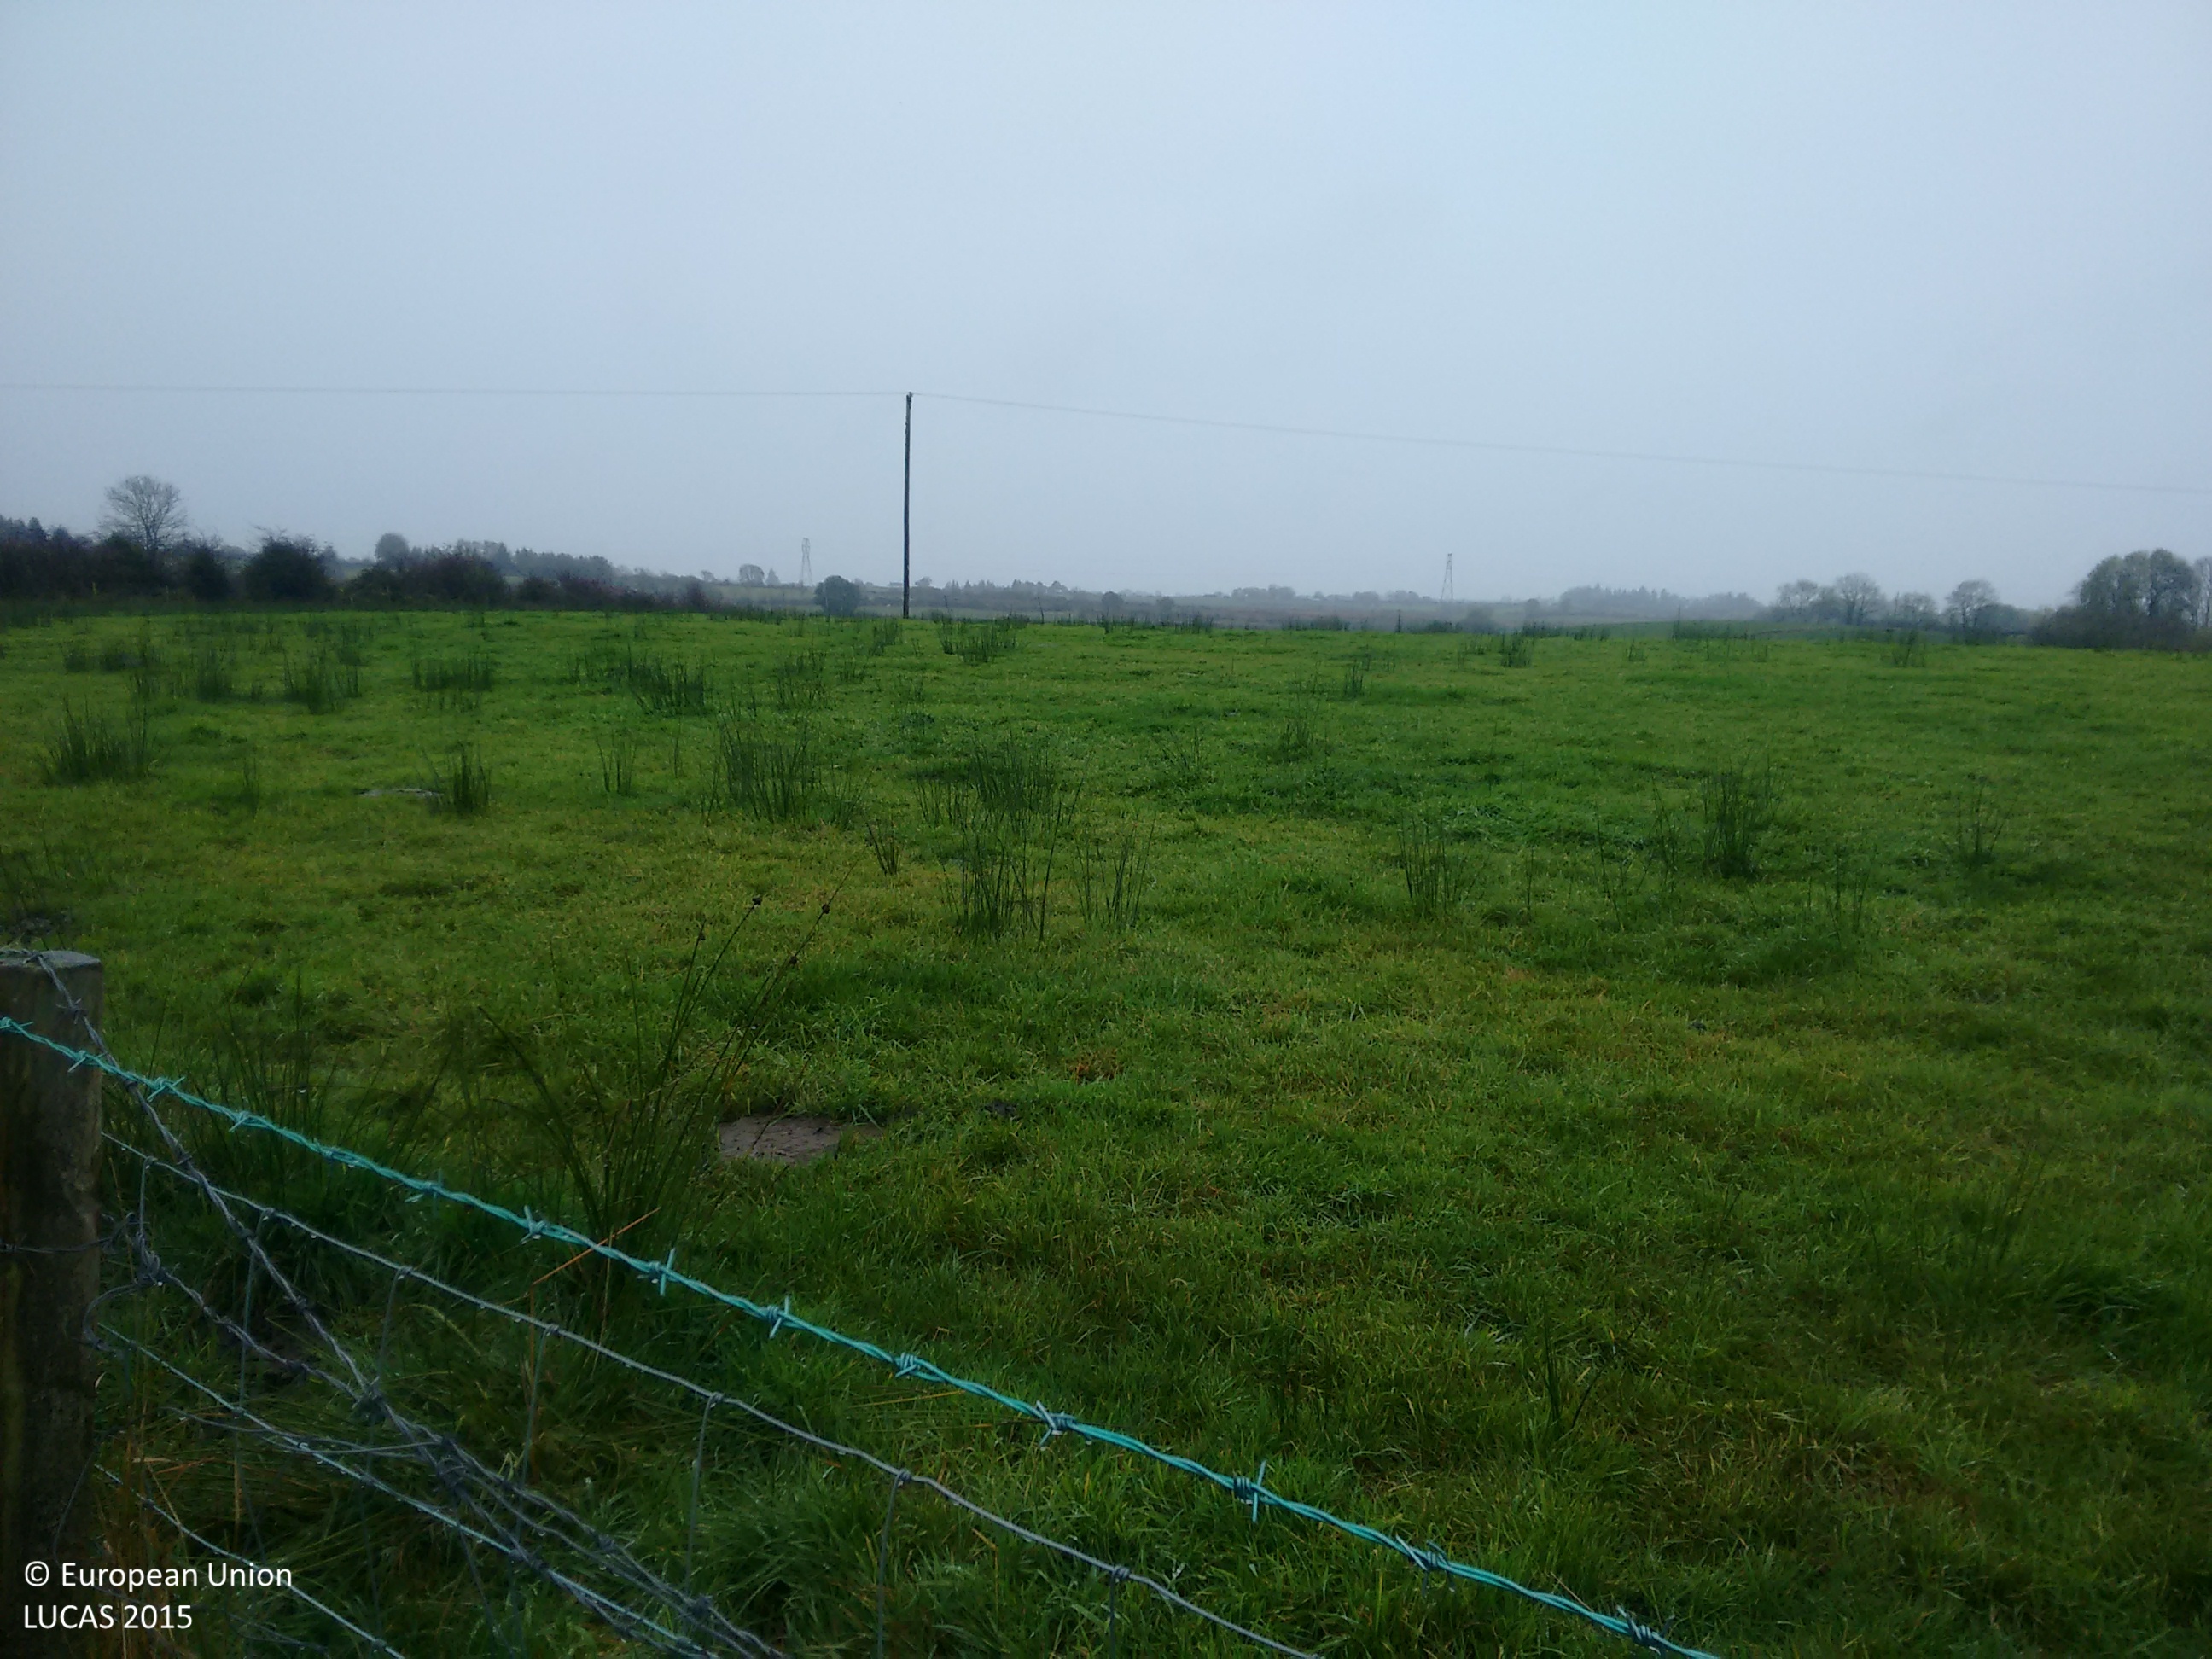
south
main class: Grassland
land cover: Grassland without tree/shrub cover
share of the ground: > 75 %
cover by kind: herbaceous plants 100 %
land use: Agriculture (excluding fallow land and kitchen gardens)
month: October
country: IE
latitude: 53.9045
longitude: -8.2189
